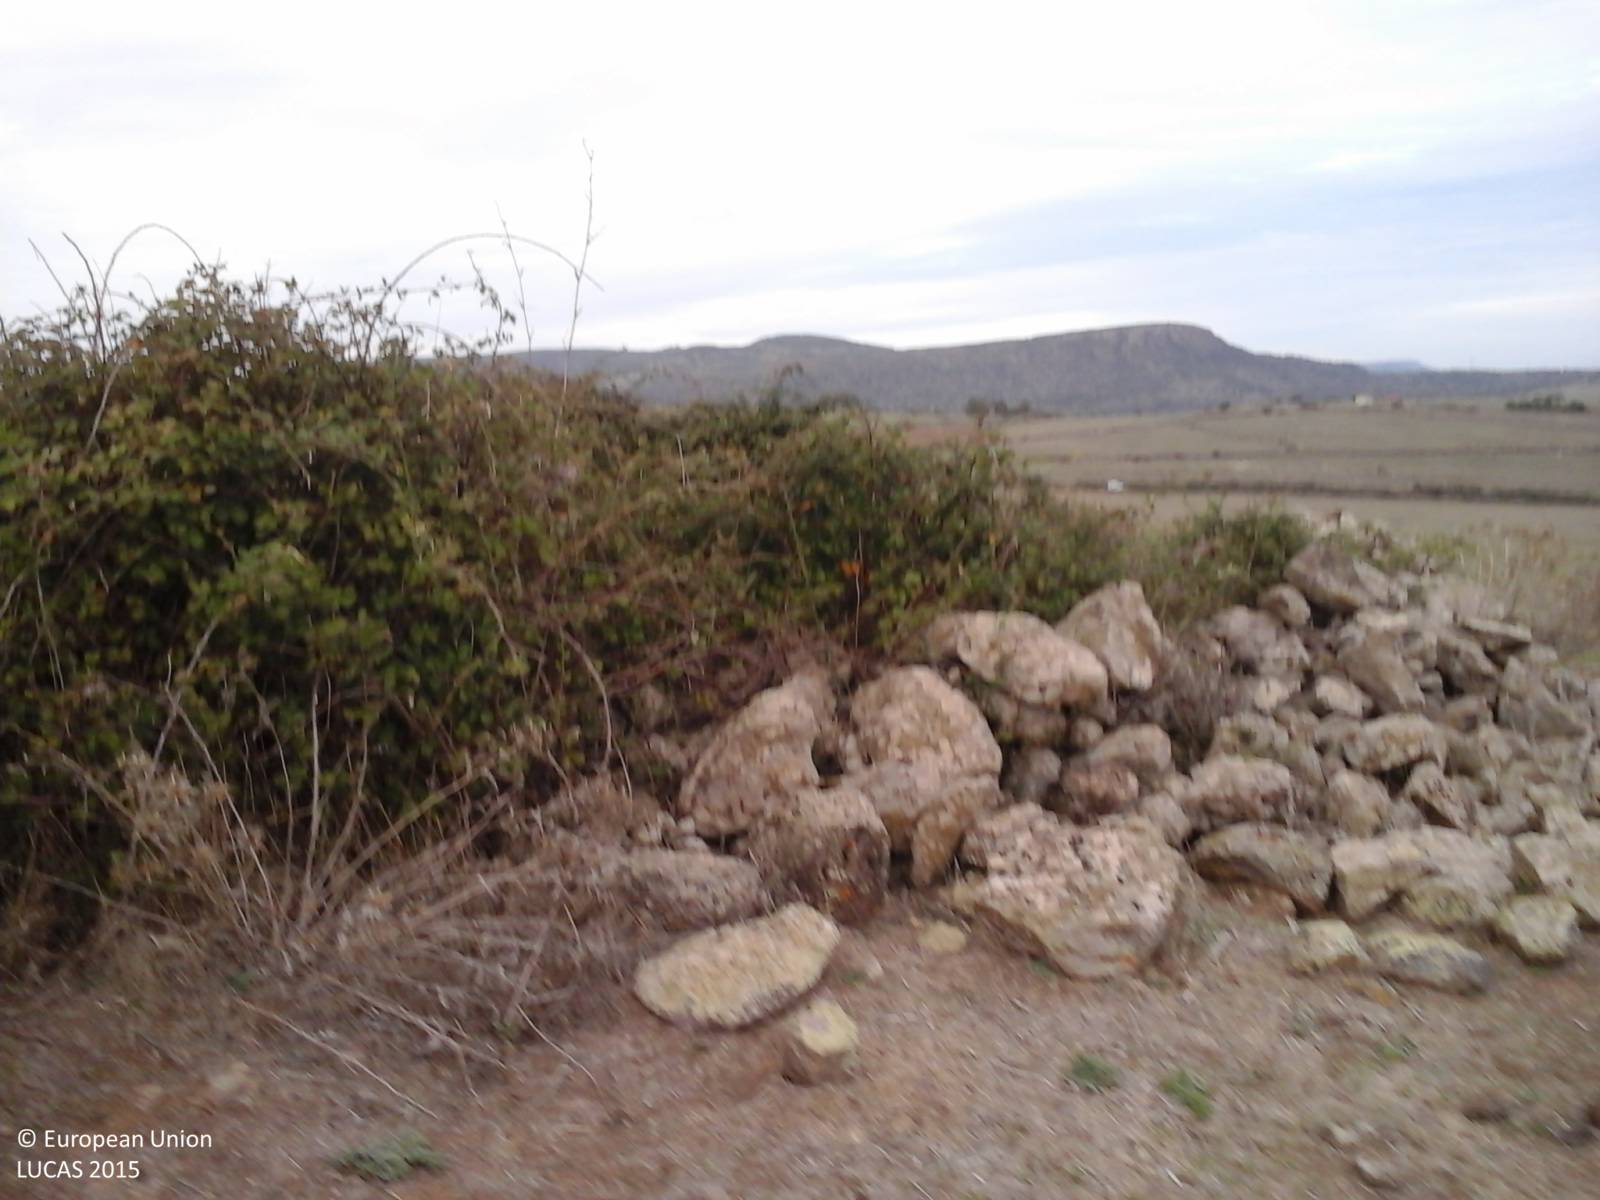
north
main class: Grassland
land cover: Grassland without tree/shrub cover
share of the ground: > 75 %
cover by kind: herbaceous plants 100 %
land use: Agriculture (excluding fallow land and kitchen gardens)
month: October
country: IT
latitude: 40.4032
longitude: 8.6753
